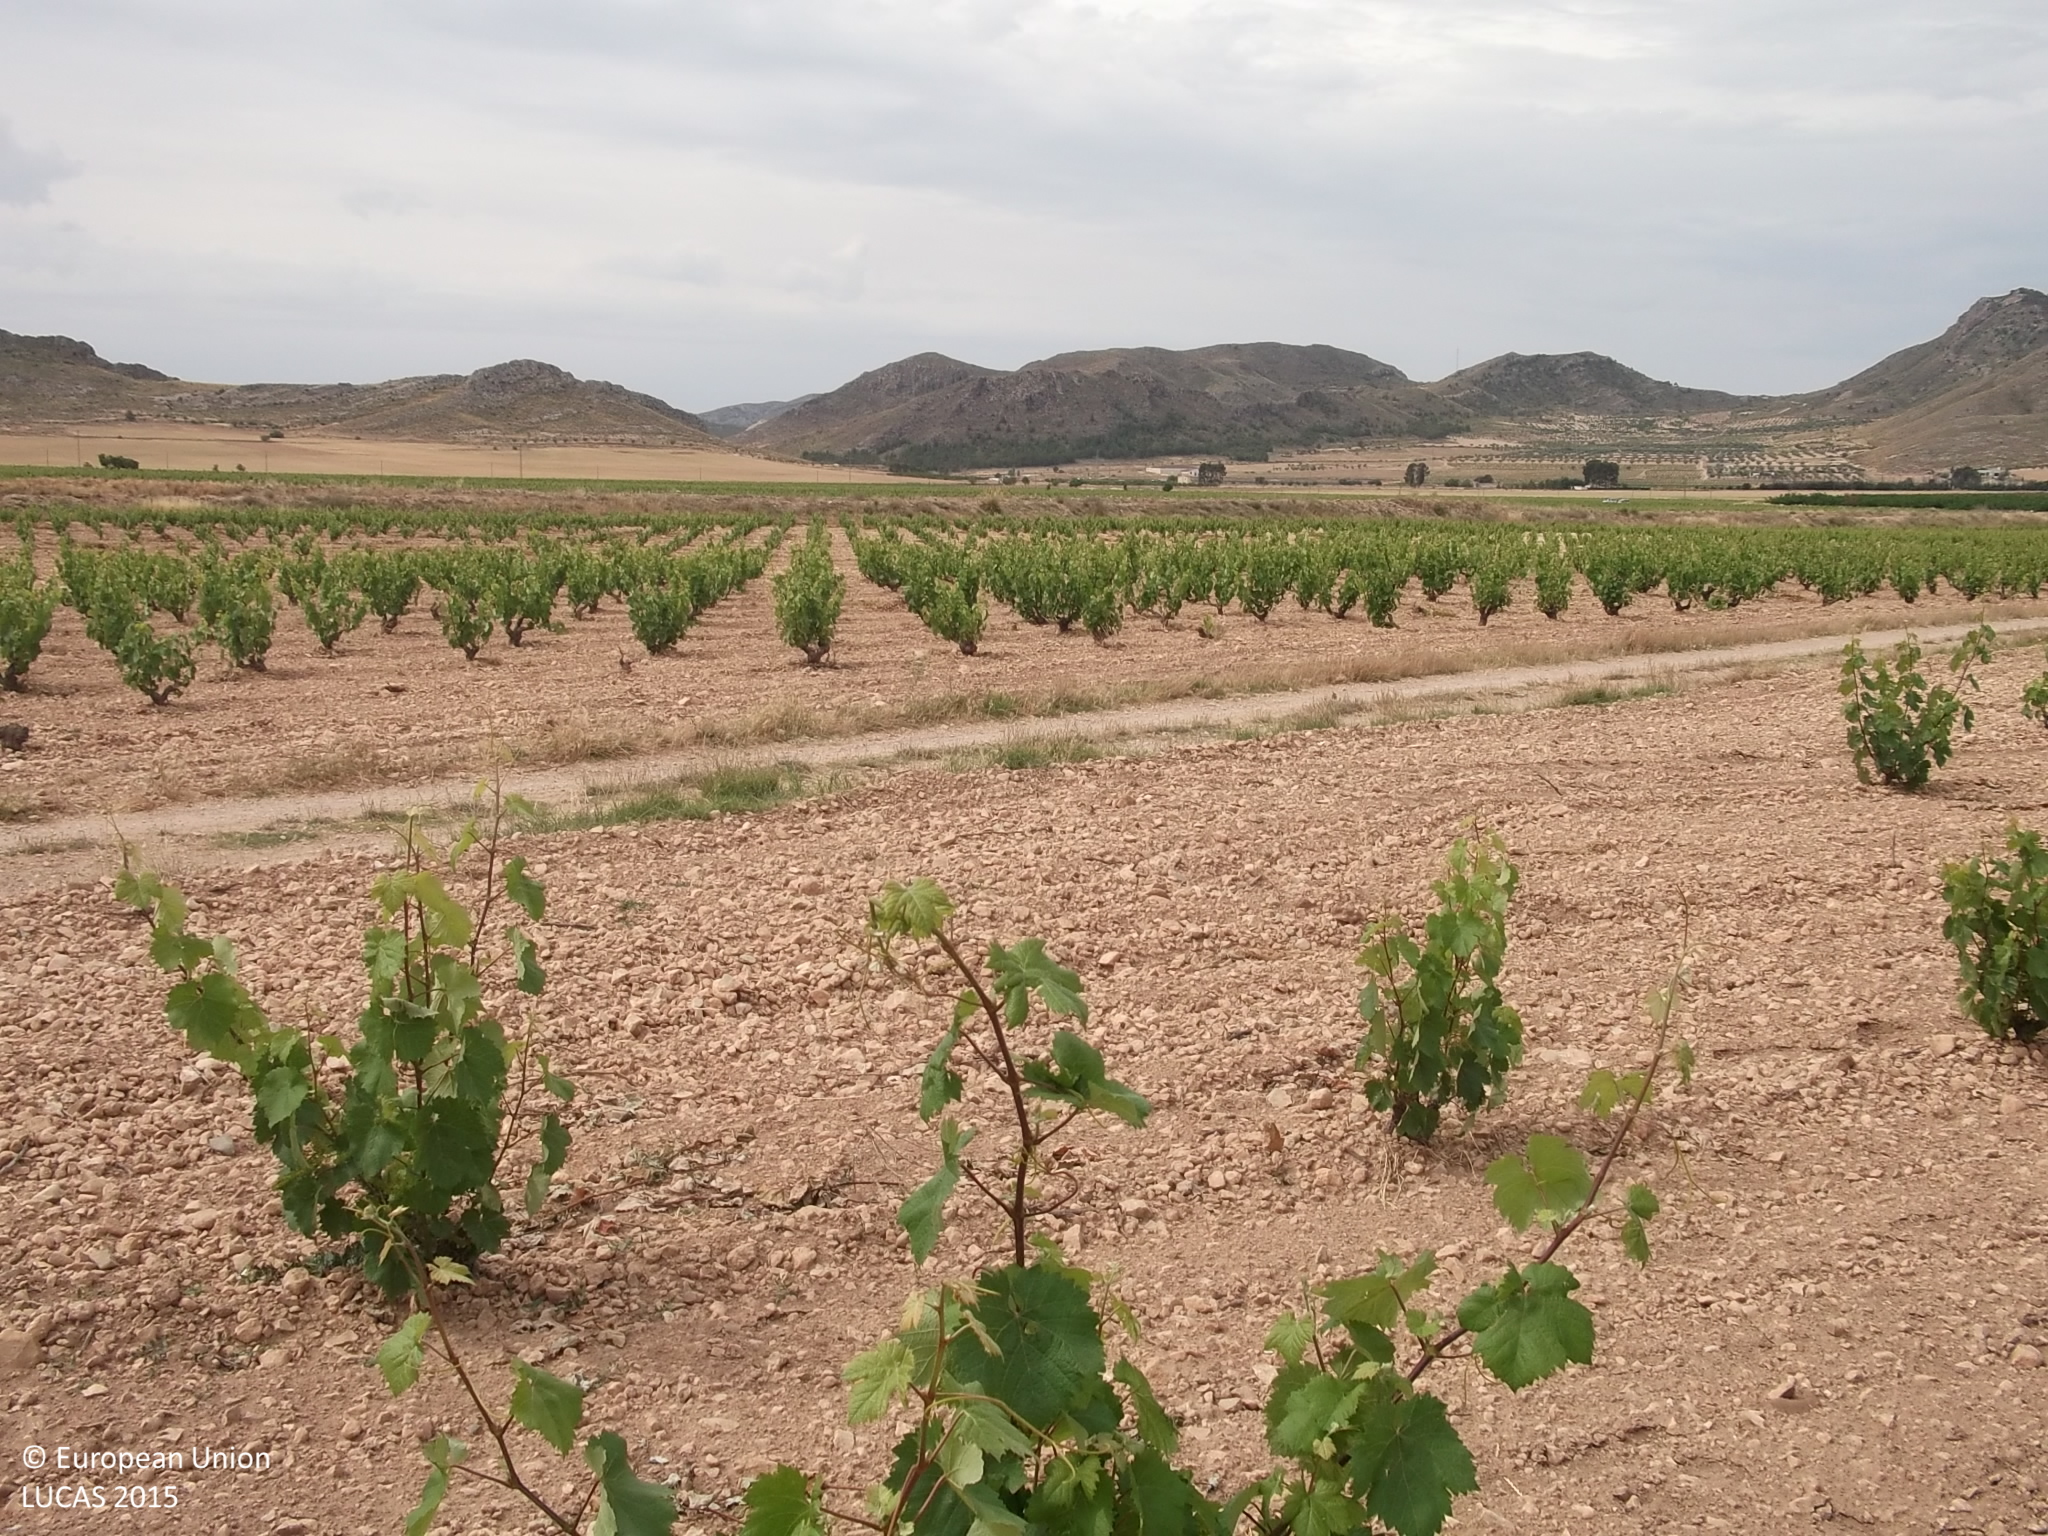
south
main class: Cropland
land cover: Vineyards
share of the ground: 10 - 25 %
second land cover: Other bare soil
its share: > 75 %
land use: Agriculture (excluding fallow land and kitchen gardens)
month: May
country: ES
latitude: 38.5277
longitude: -1.3591
